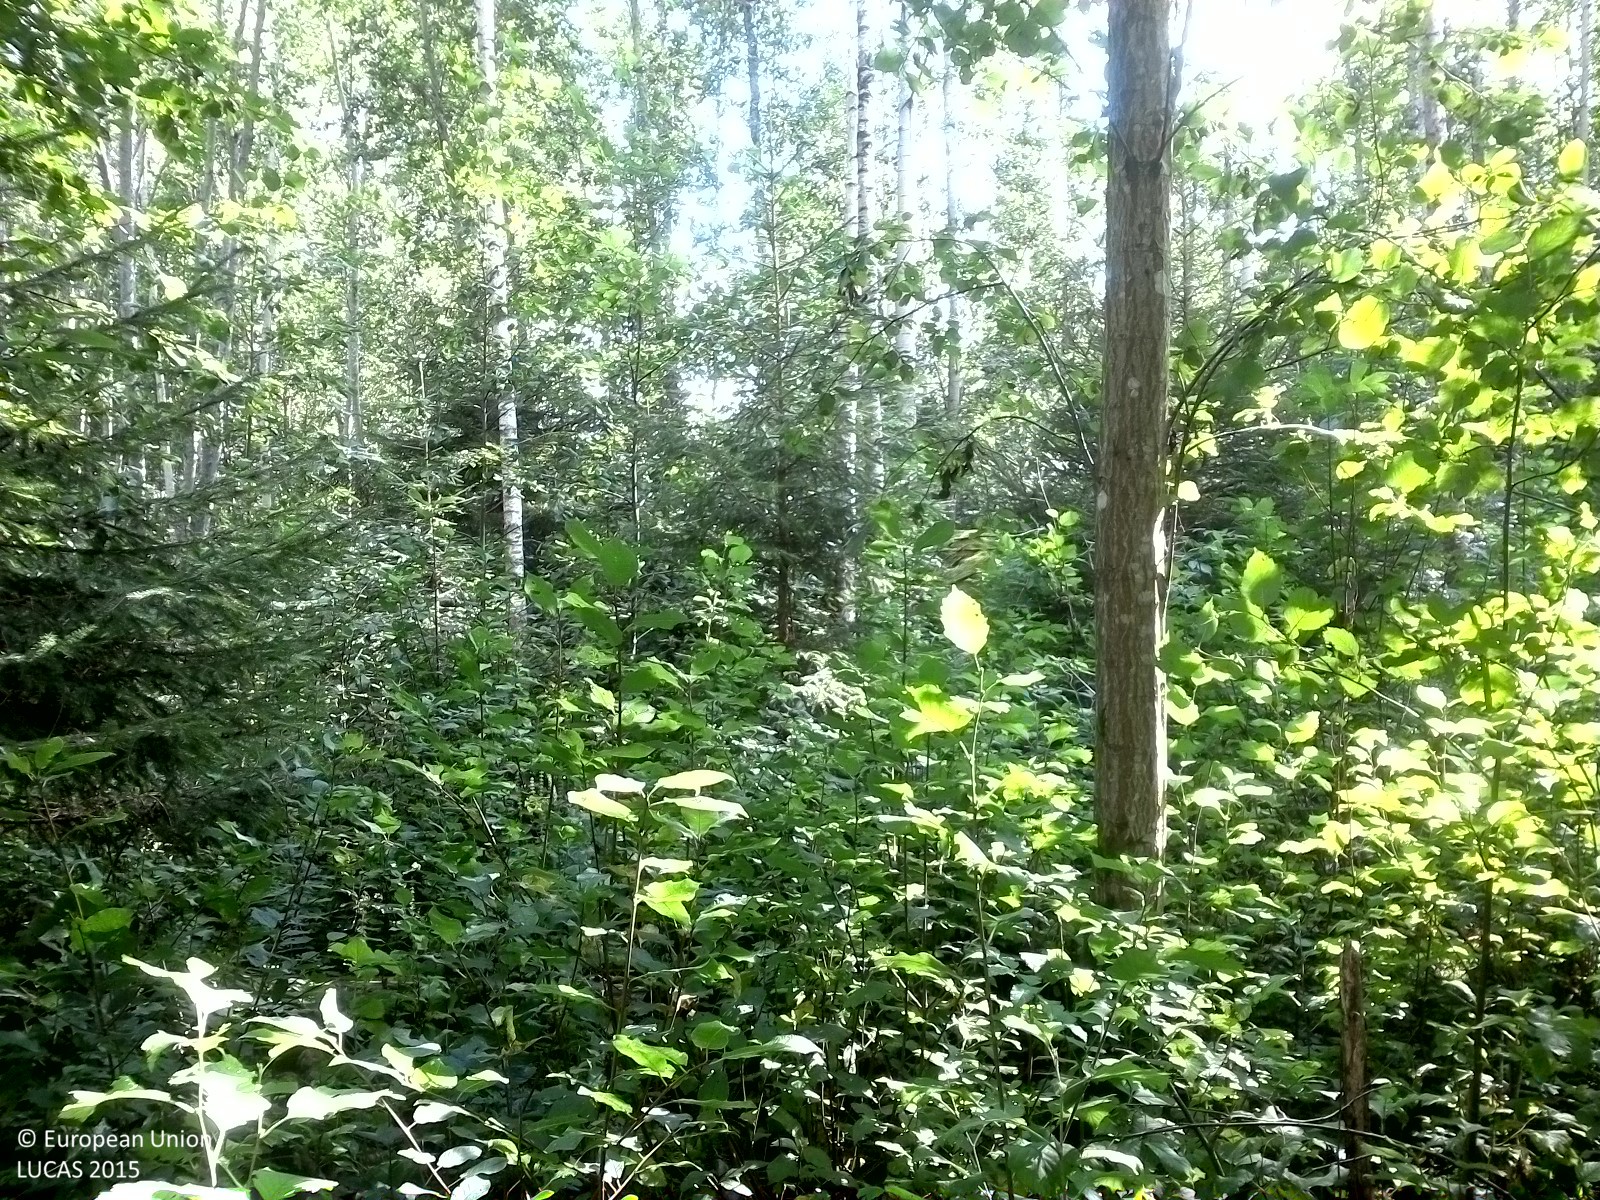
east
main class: Woodland
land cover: Broadleaved woodland
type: hemiboreal forest and nemoral coniferous forest and mixed broadleaved-coniferous forest
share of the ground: 50 - 75 %
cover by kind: broadleaved forest trees 65 %, shrubs 10 %, herbaceous plants 10 %, coniferous forest trees 5 %, lichens and mosses 5 %, unconsolidated bare surface 5 %
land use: Forestry
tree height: > 5 m
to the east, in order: Broadleaved woodland; Tracks; Broadleaved woodland; Spontaneously vegetated surfaces; Broadleaved woodland; Ditches and canals; Broadleaved woodland; Paved roads, cycling and walking lanes; Broadleaved woodland
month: August
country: SE
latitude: 59.1324
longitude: 15.5667
